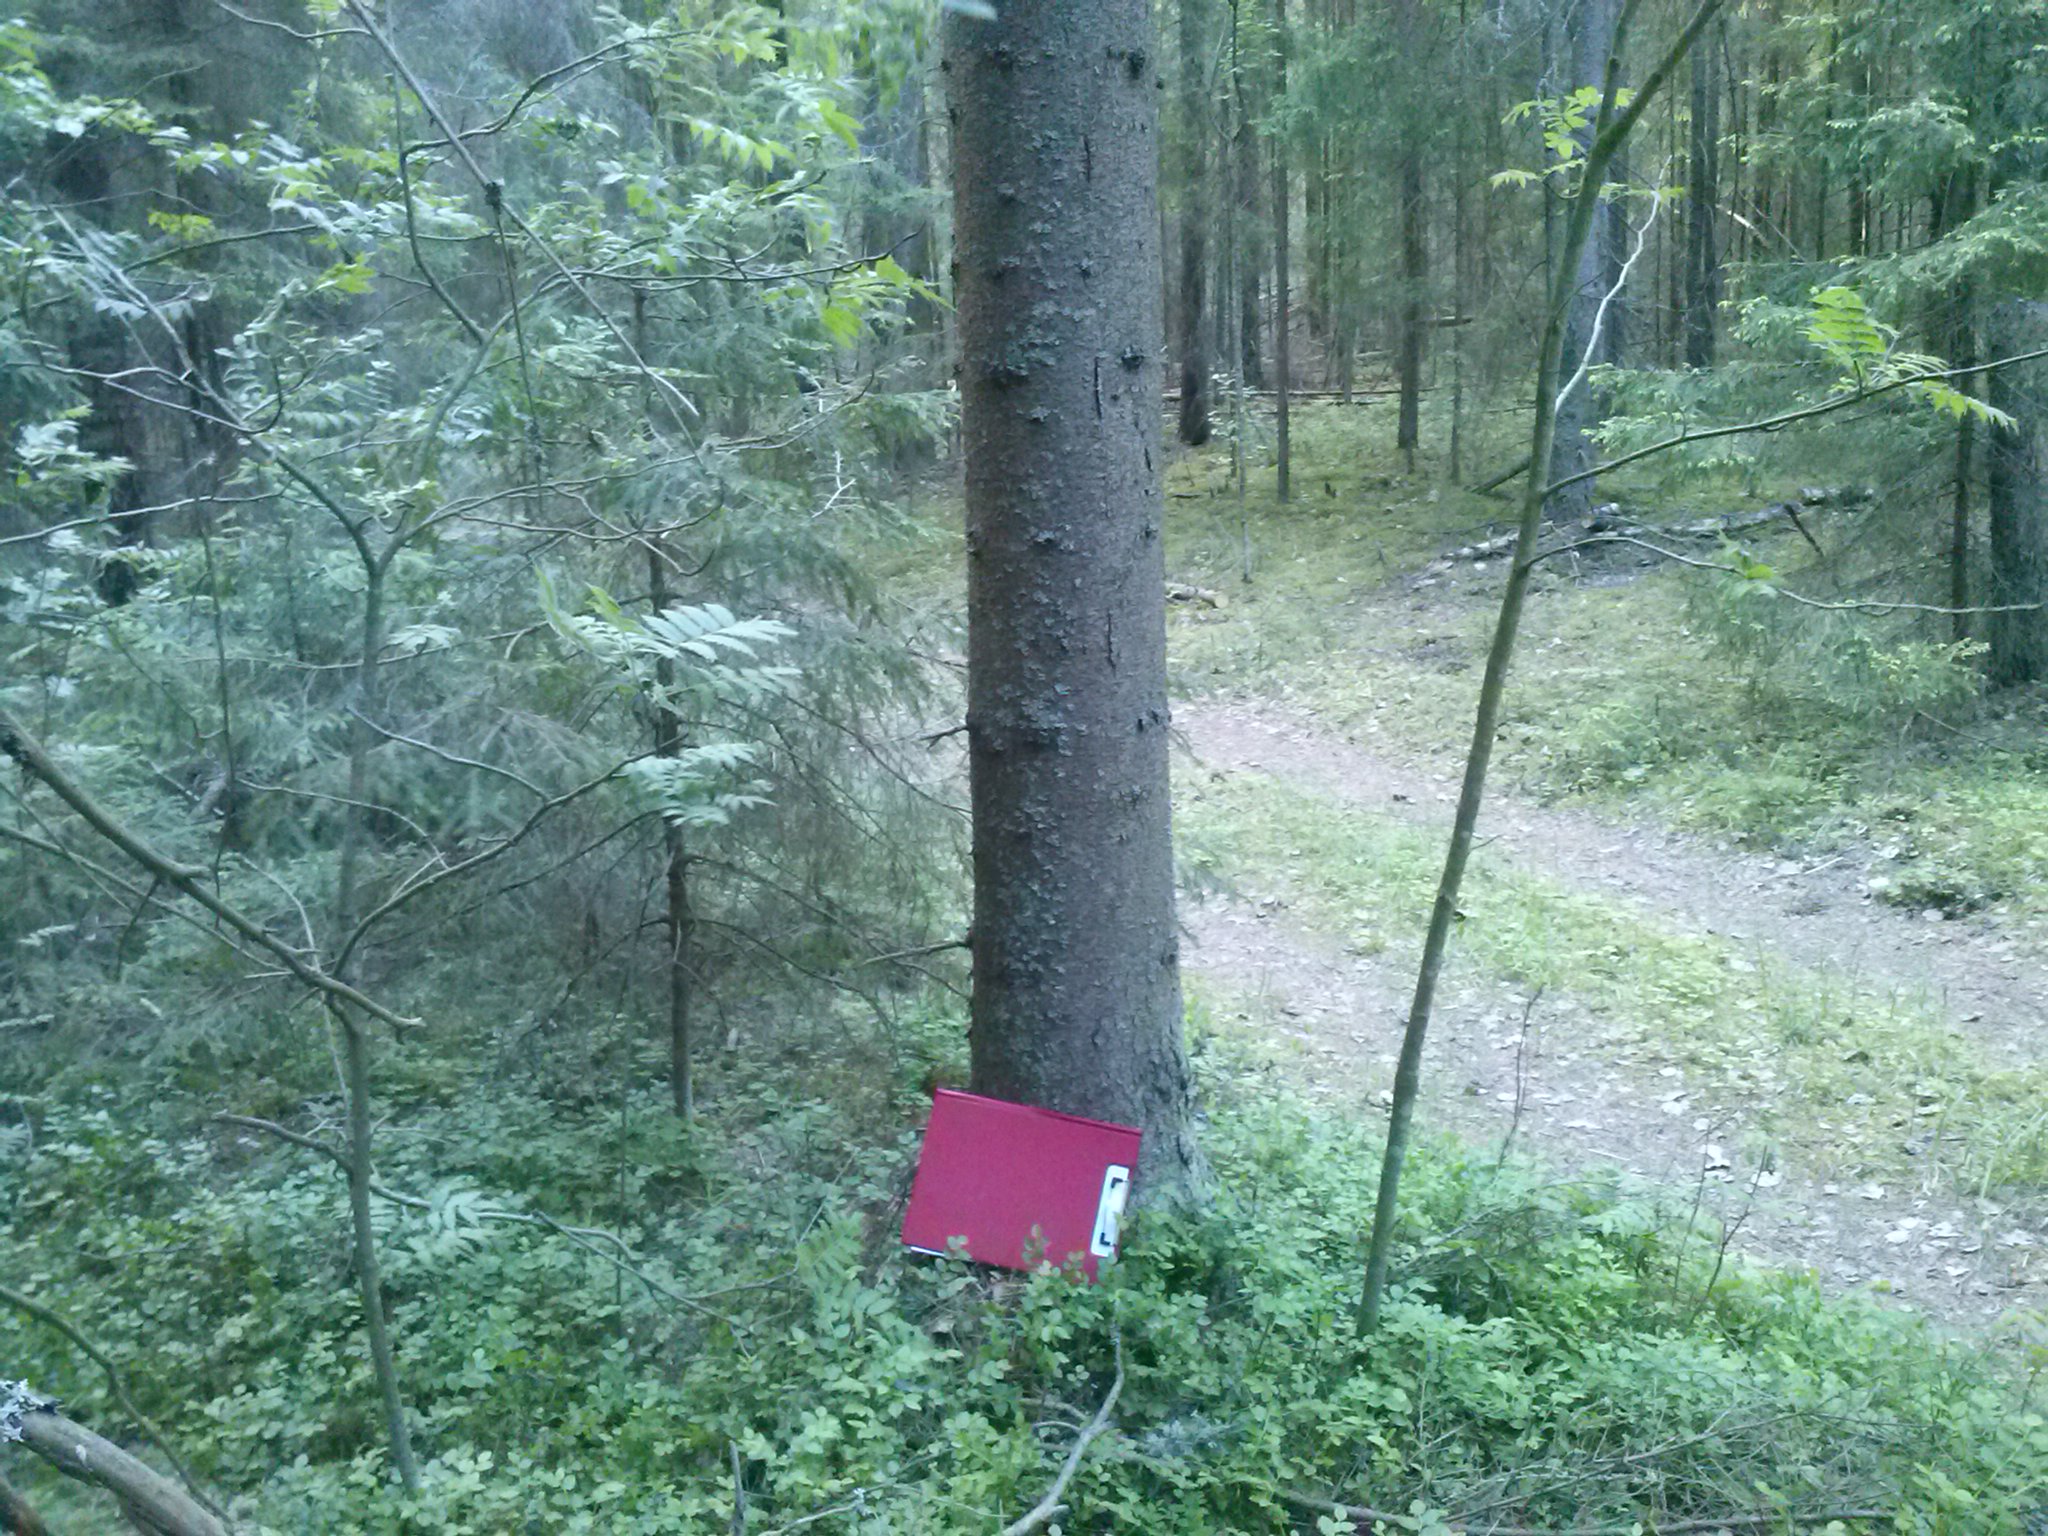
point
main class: Woodland
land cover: Spruce dominated coniferous woodland
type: hemiboreal forest and nemoral coniferous forest and mixed broadleaved-coniferous forest
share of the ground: > 75 %
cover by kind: coniferous forest trees 75 %, shrubs 10 %, herbaceous plants 10 %, unconsolidated bare surface 5 %
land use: Forestry
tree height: > 5 m
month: June
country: LV
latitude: 56.3660
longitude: 27.6857
